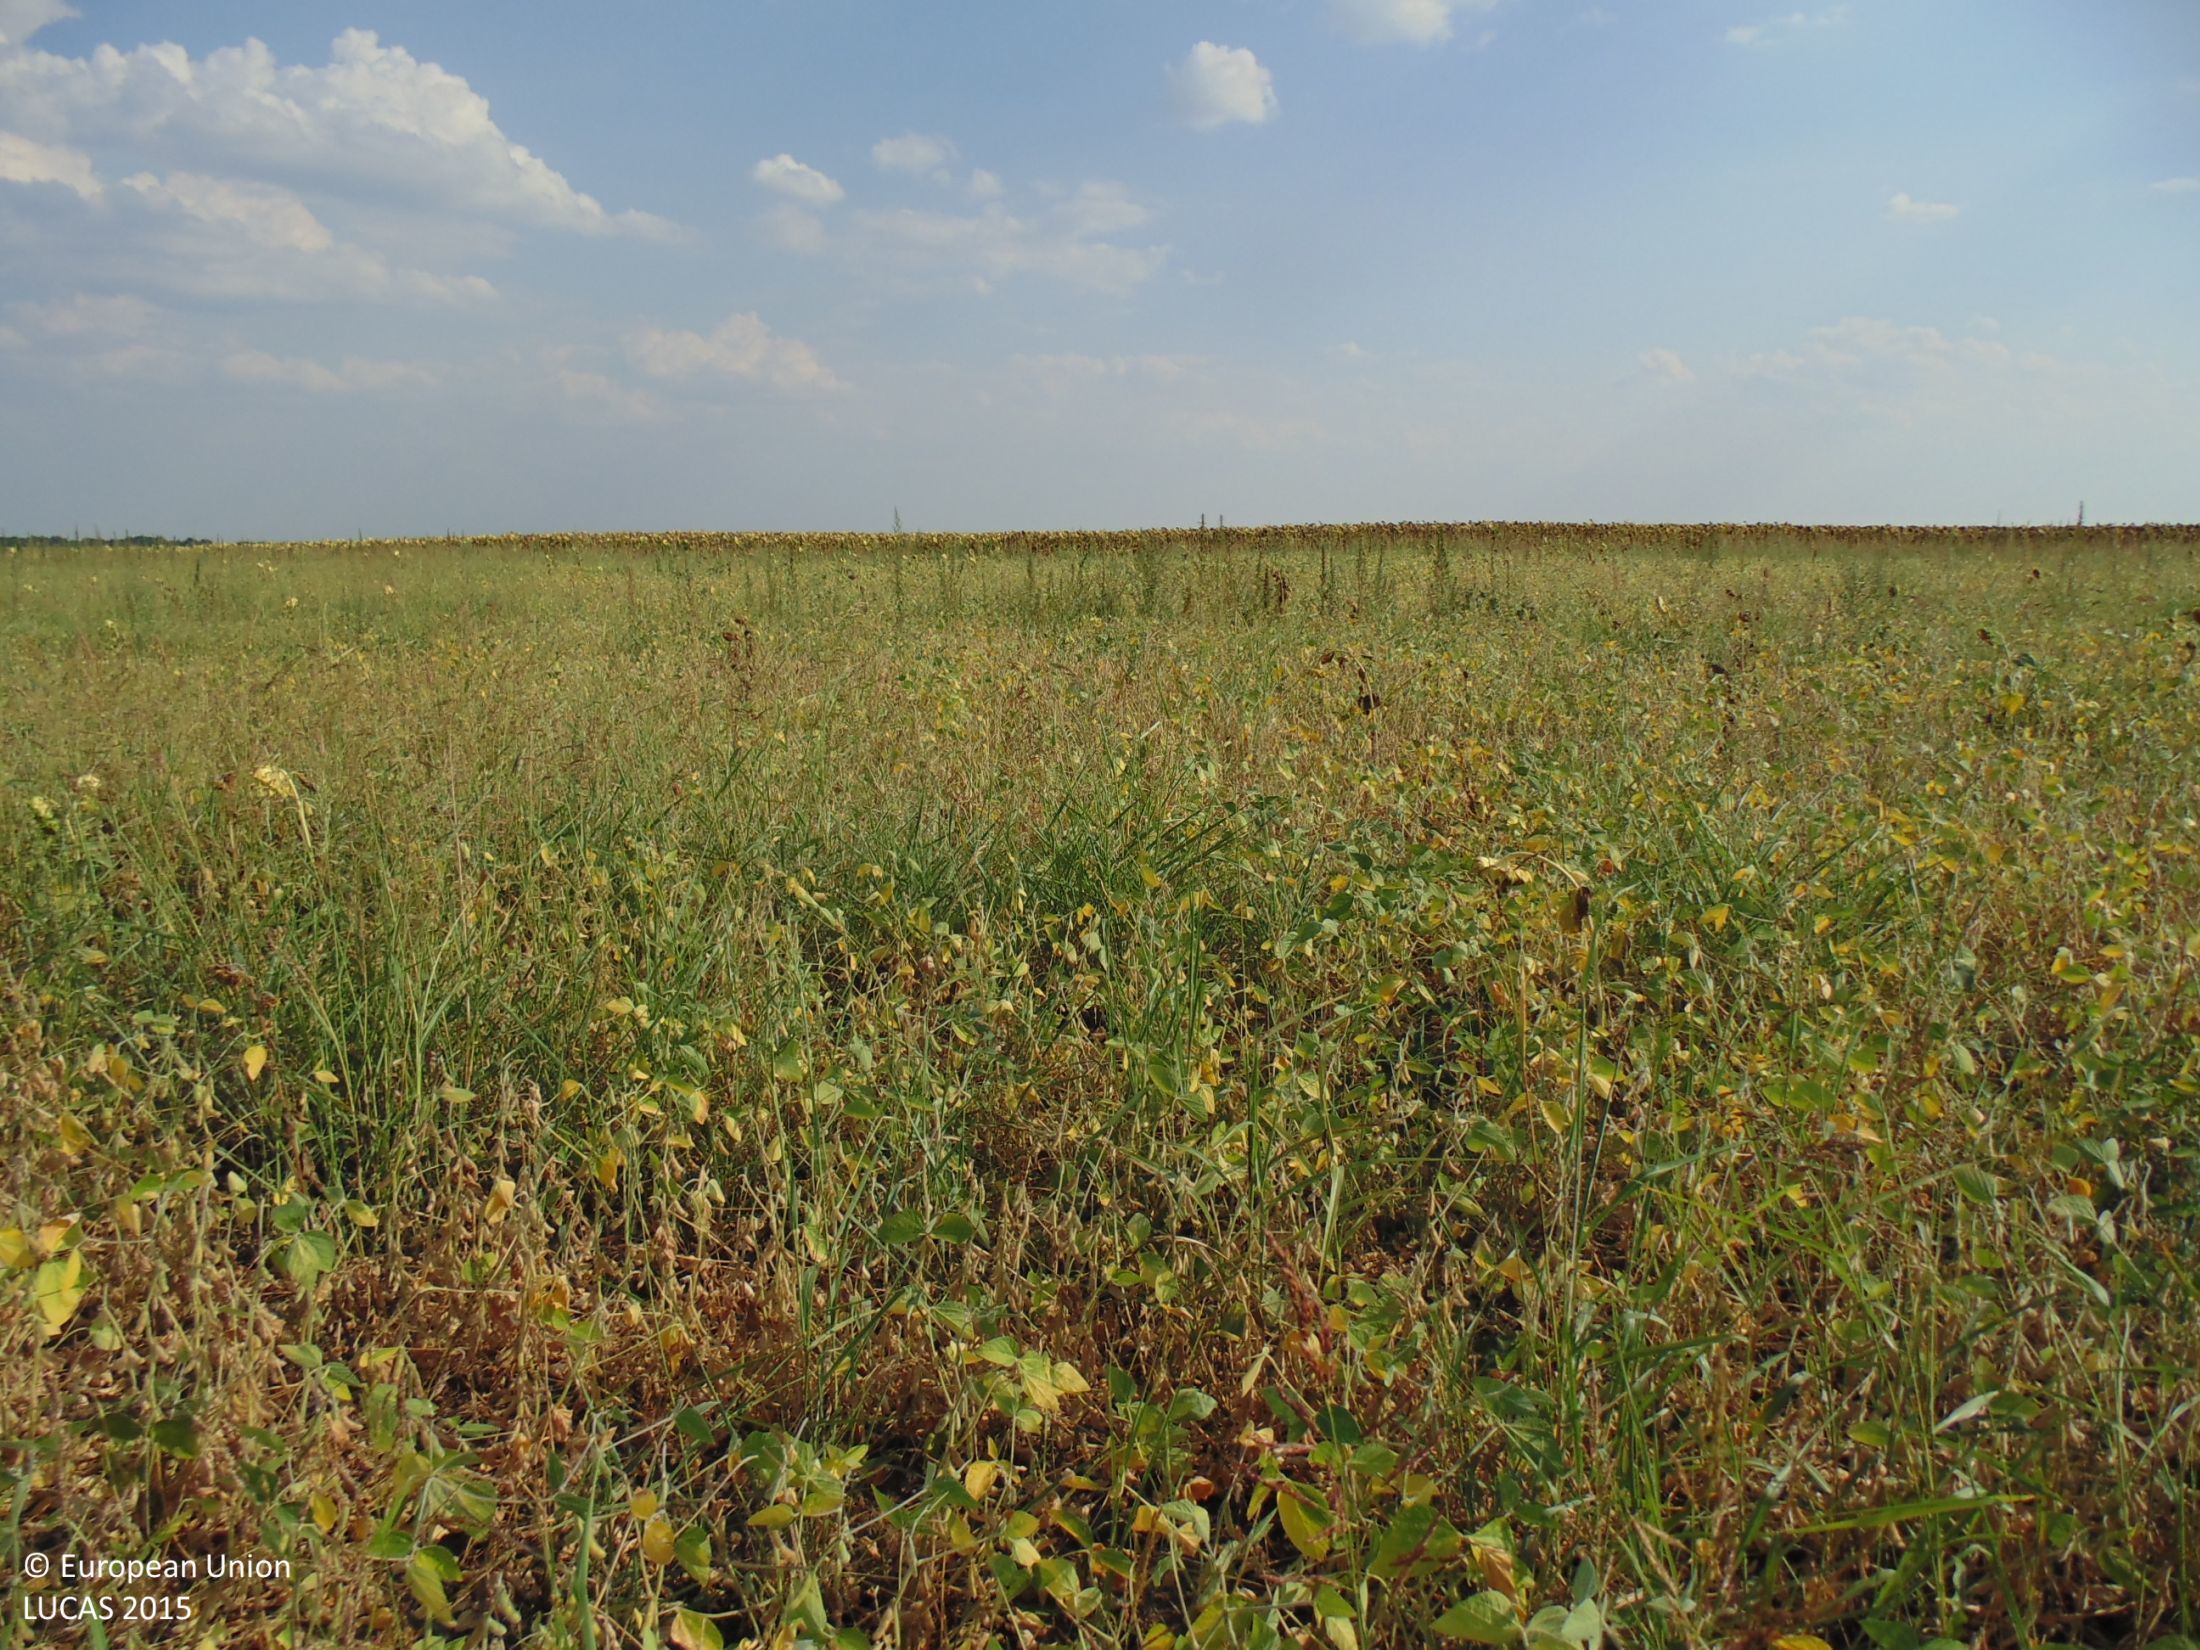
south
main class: Cropland
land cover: Soya
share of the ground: > 75 %
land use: Agriculture (excluding fallow land and kitchen gardens)
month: August
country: BG
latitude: 43.9120
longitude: 27.5332
